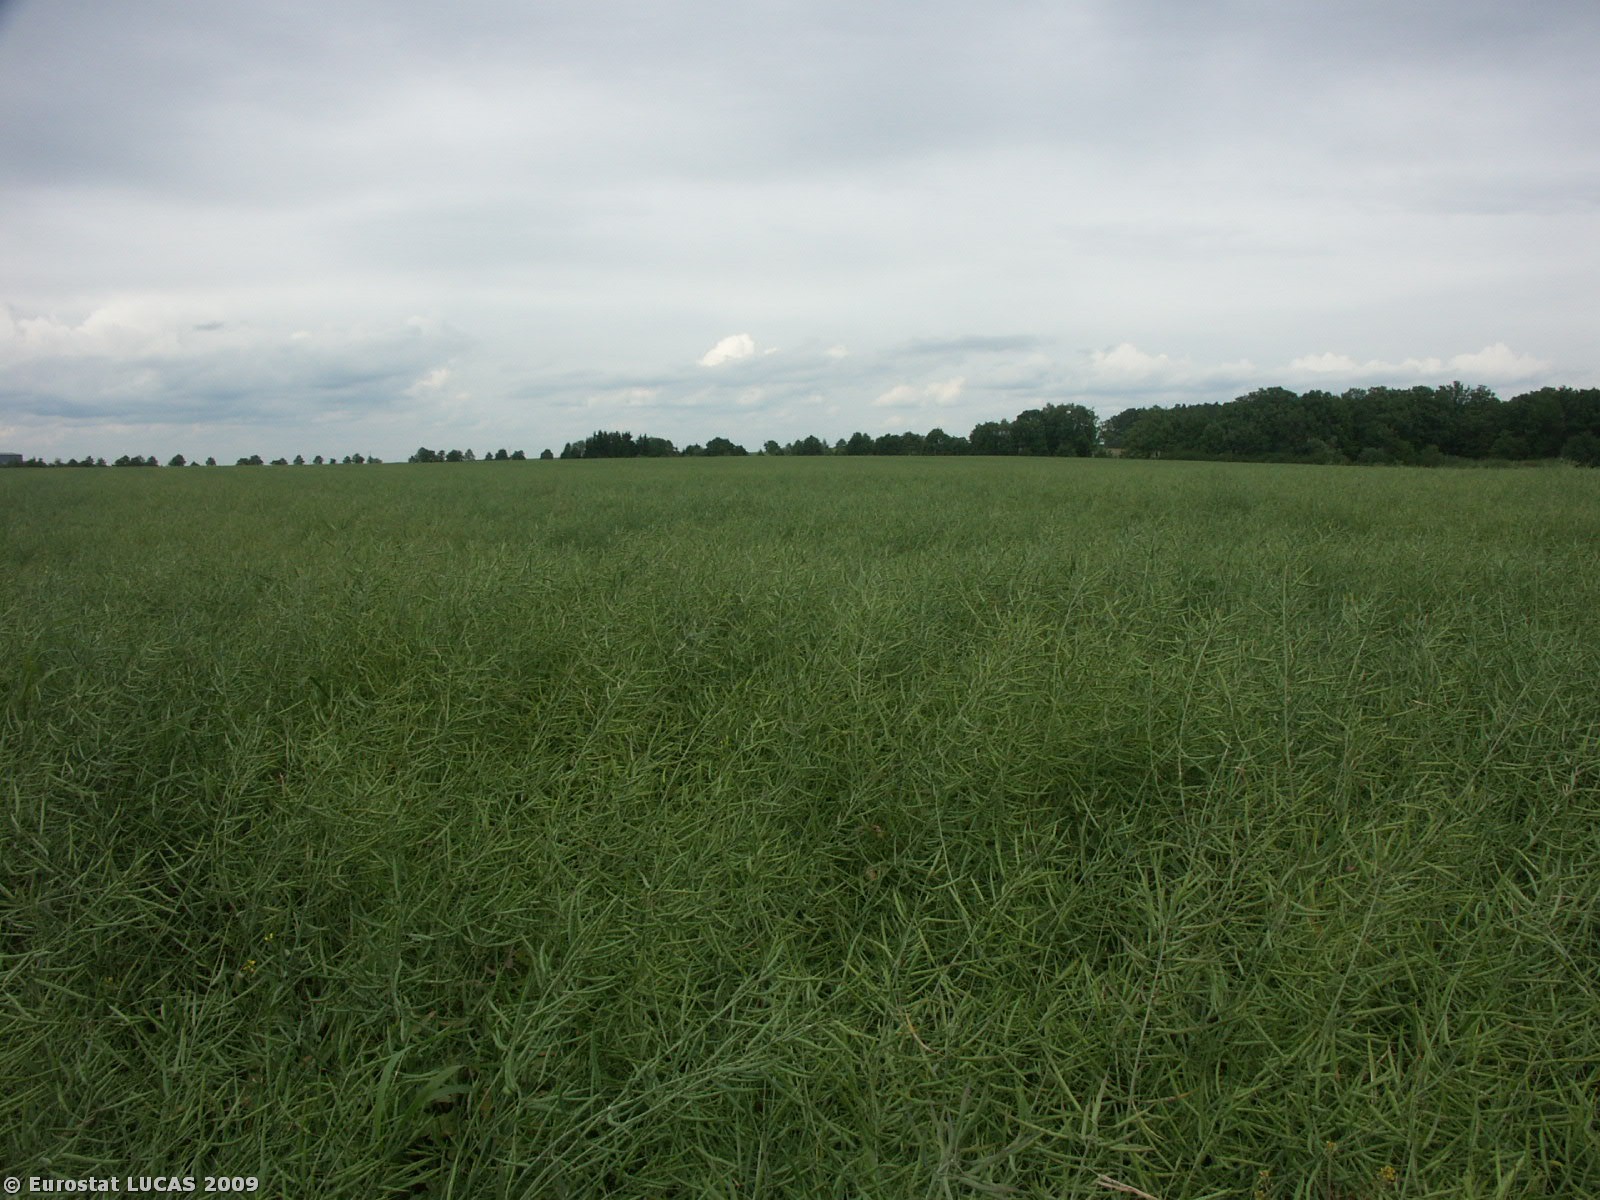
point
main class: Cropland
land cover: Rape and turnip rape
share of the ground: > 75 %
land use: Agriculture (excluding fallow land and kitchen gardens)
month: June
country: CZ
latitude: 49.0091
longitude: 14.6360
